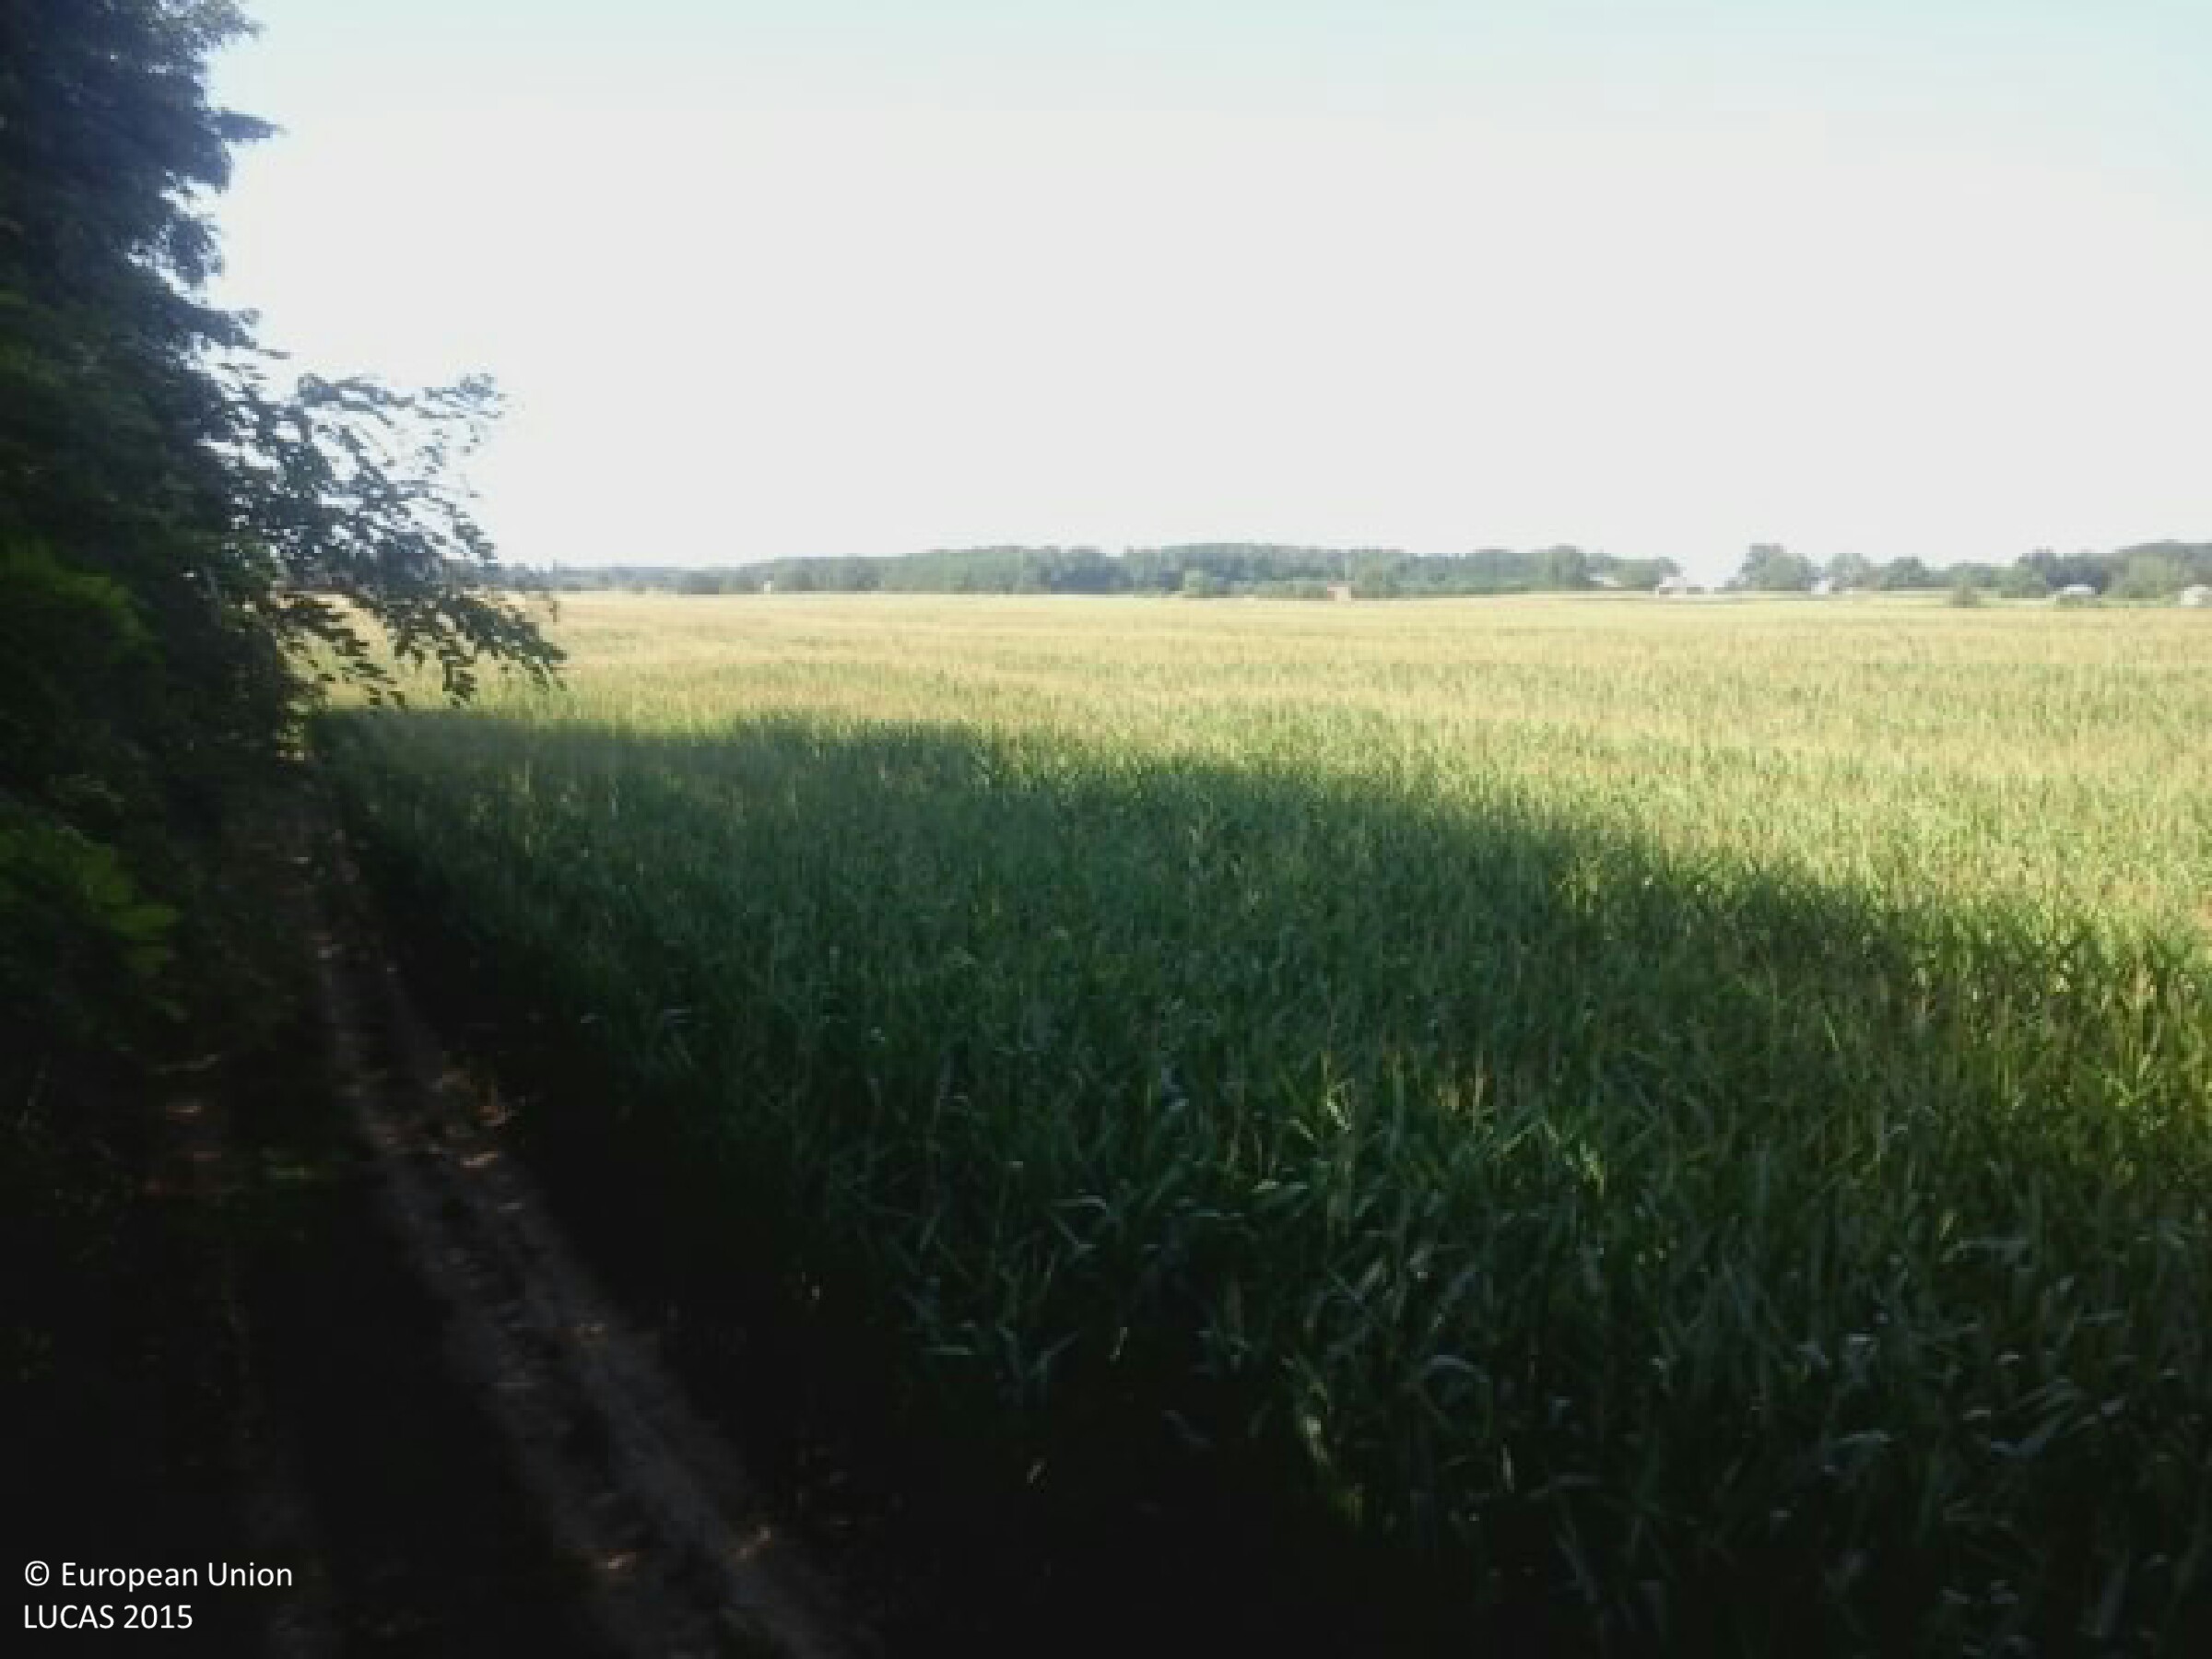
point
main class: Cropland
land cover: Maize
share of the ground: > 75 %
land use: Agriculture (excluding fallow land and kitchen gardens)
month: July
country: HU
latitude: 46.2223
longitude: 17.1199
